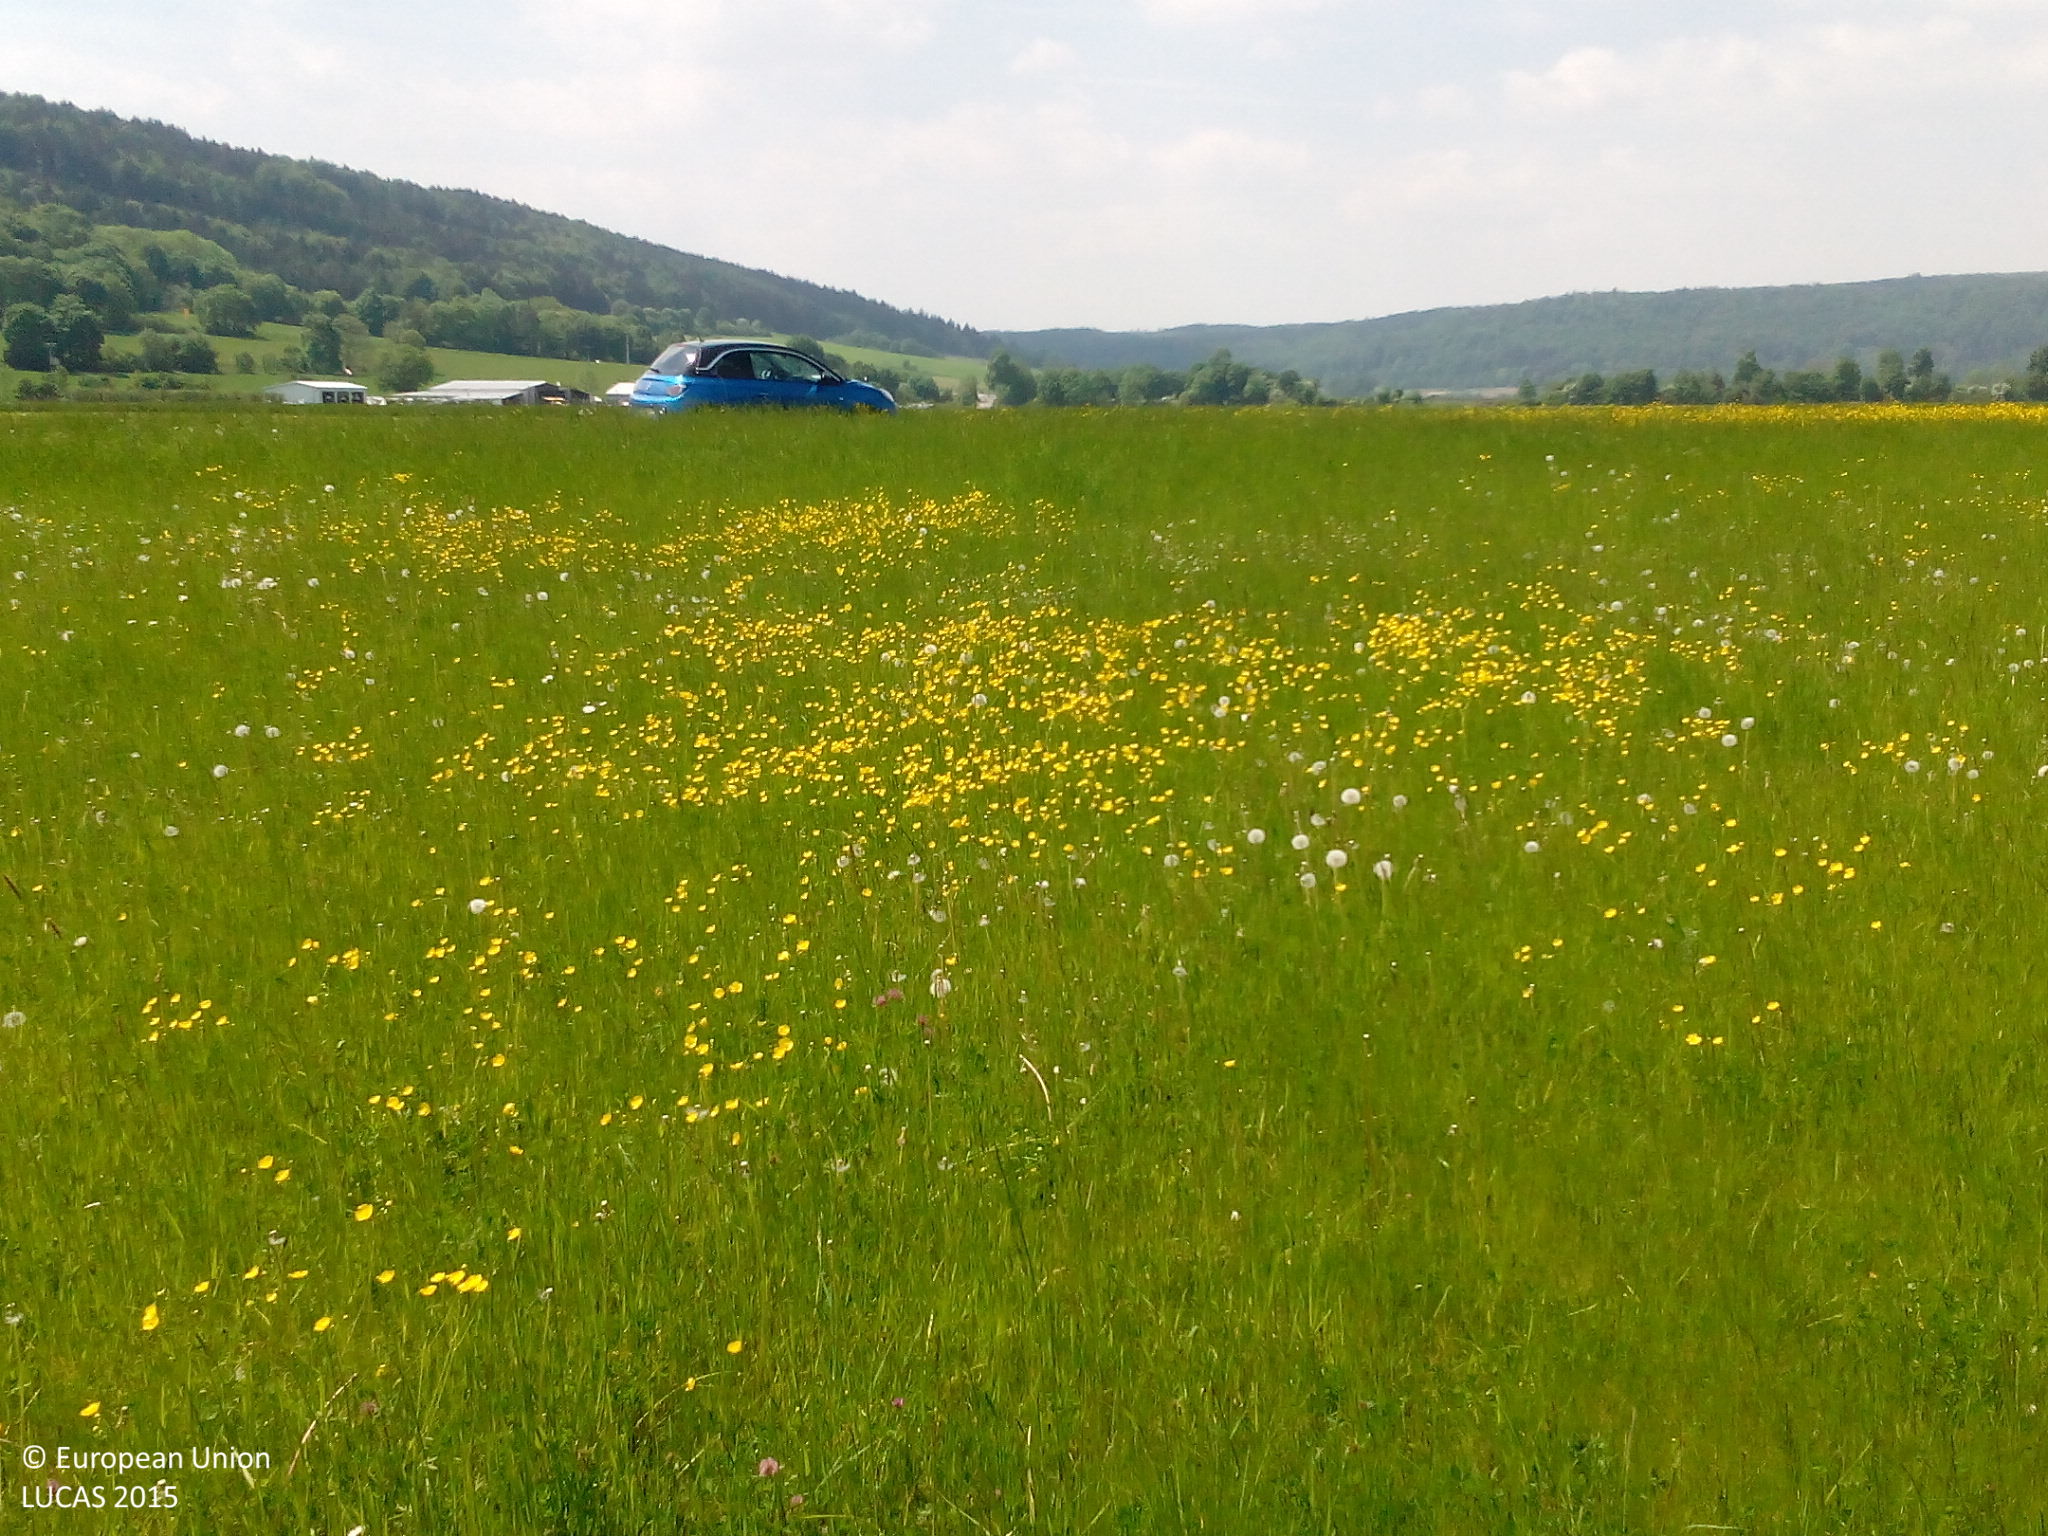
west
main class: Grassland
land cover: Grassland without tree/shrub cover
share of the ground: > 75 %
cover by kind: herbaceous plants 95 %, lichens and mosses 5 %
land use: Agriculture (excluding fallow land and kitchen gardens)
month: May
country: DE
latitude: 49.0232
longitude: 11.4900
